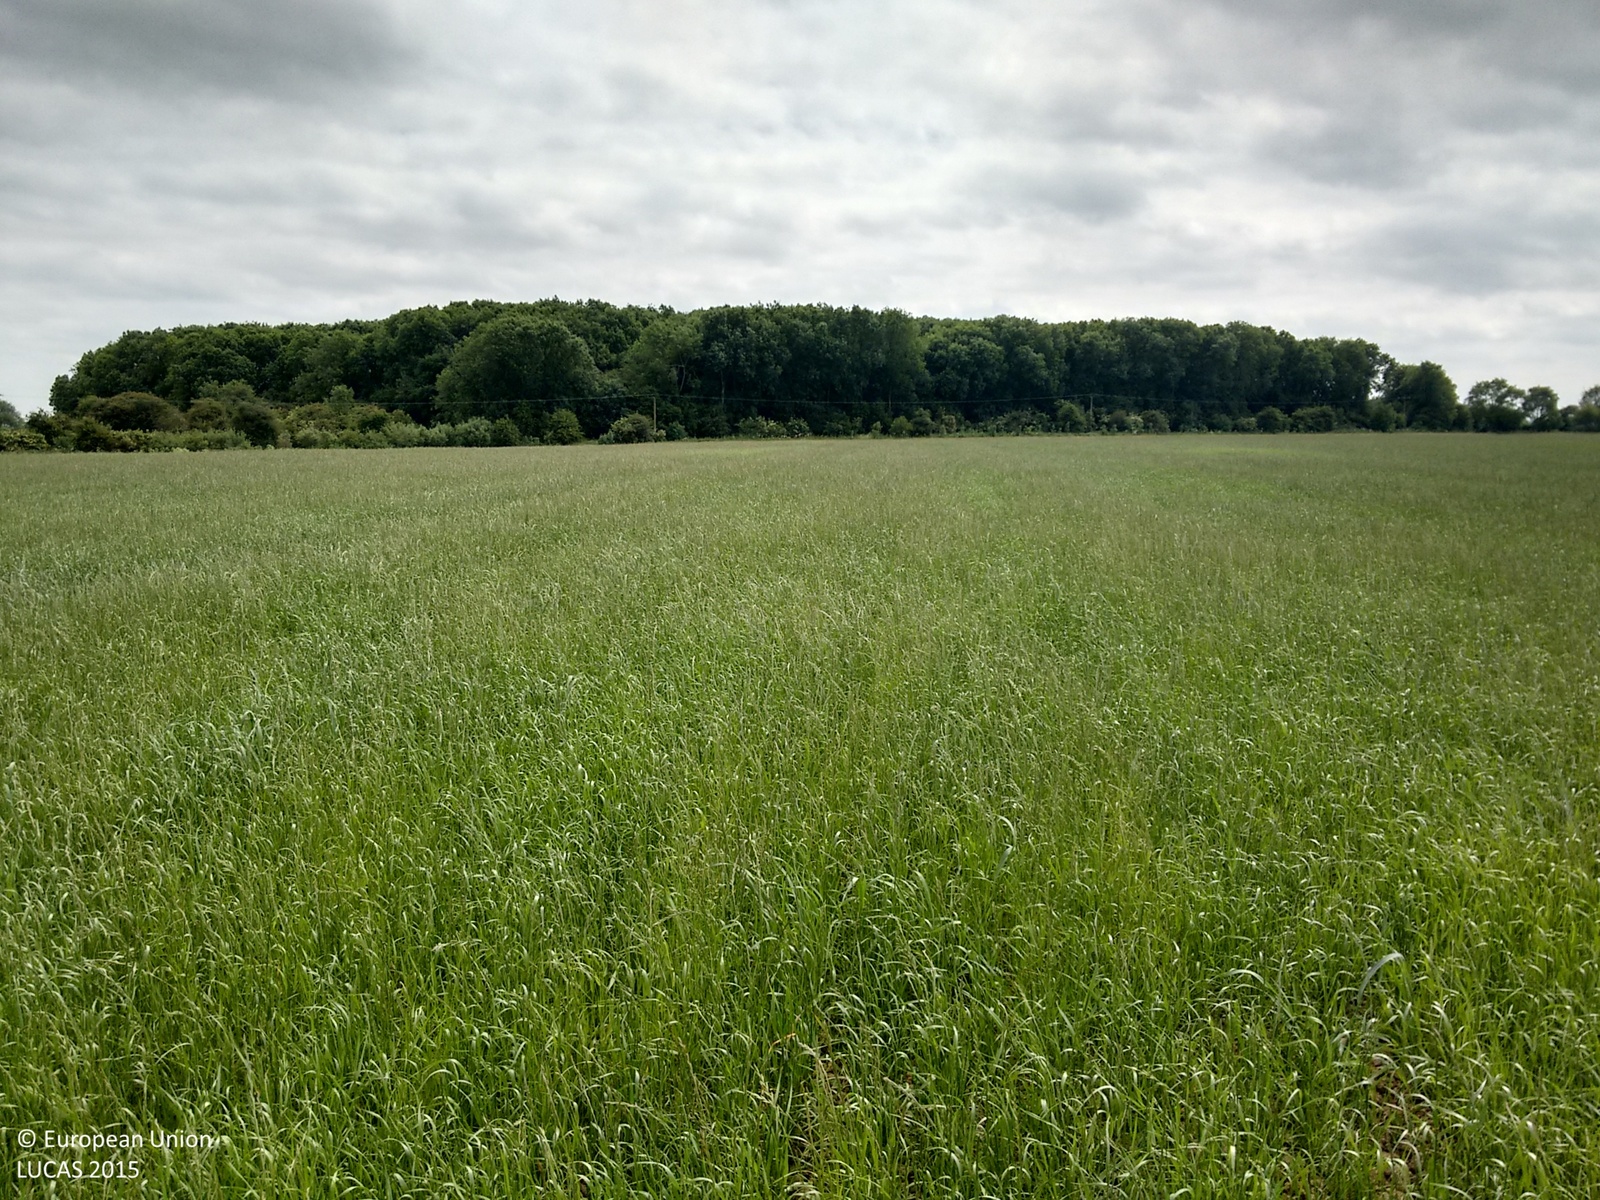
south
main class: Cropland
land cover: Barley
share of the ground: > 75 %
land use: Agriculture (excluding fallow land and kitchen gardens)
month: June
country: GB
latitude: 53.6493
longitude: -1.1342
